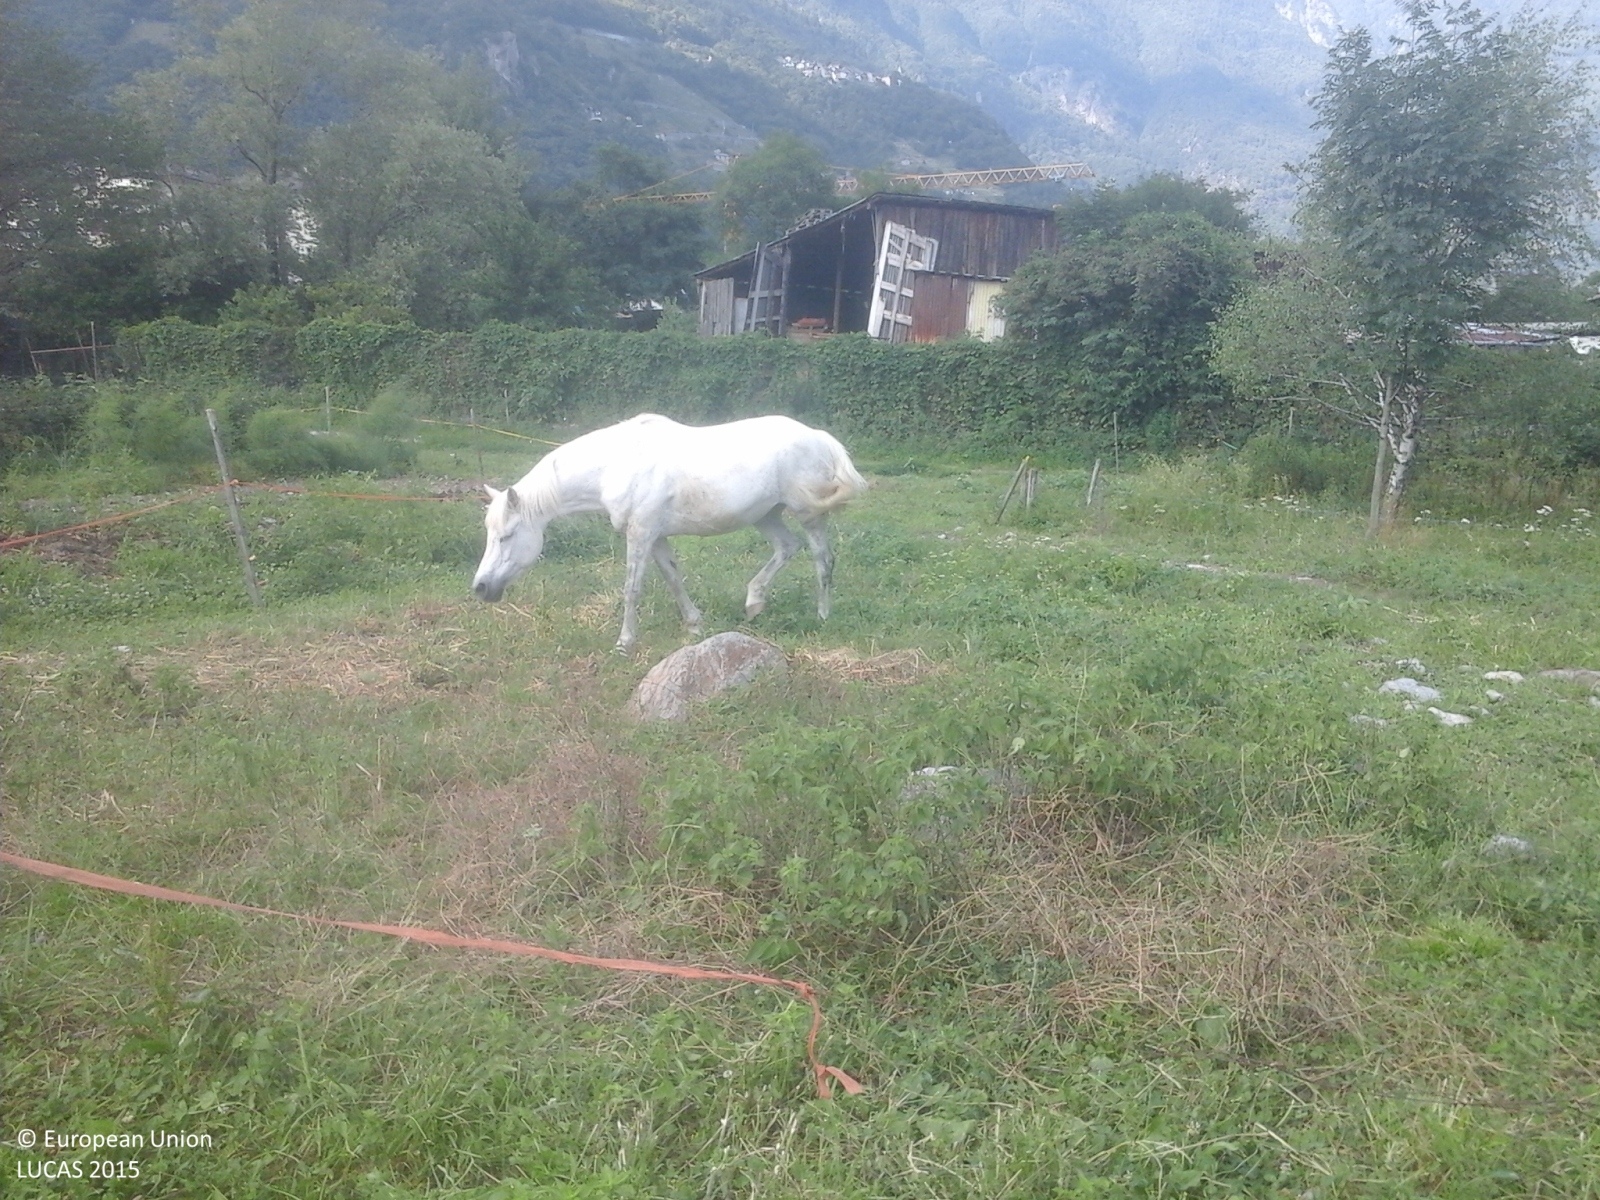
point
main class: Grassland
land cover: Grassland without tree/shrub cover
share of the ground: > 75 %
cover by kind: herbaceous plants 100 %
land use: Agriculture (excluding fallow land and kitchen gardens)
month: July
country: IT
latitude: 46.3134
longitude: 9.3905
